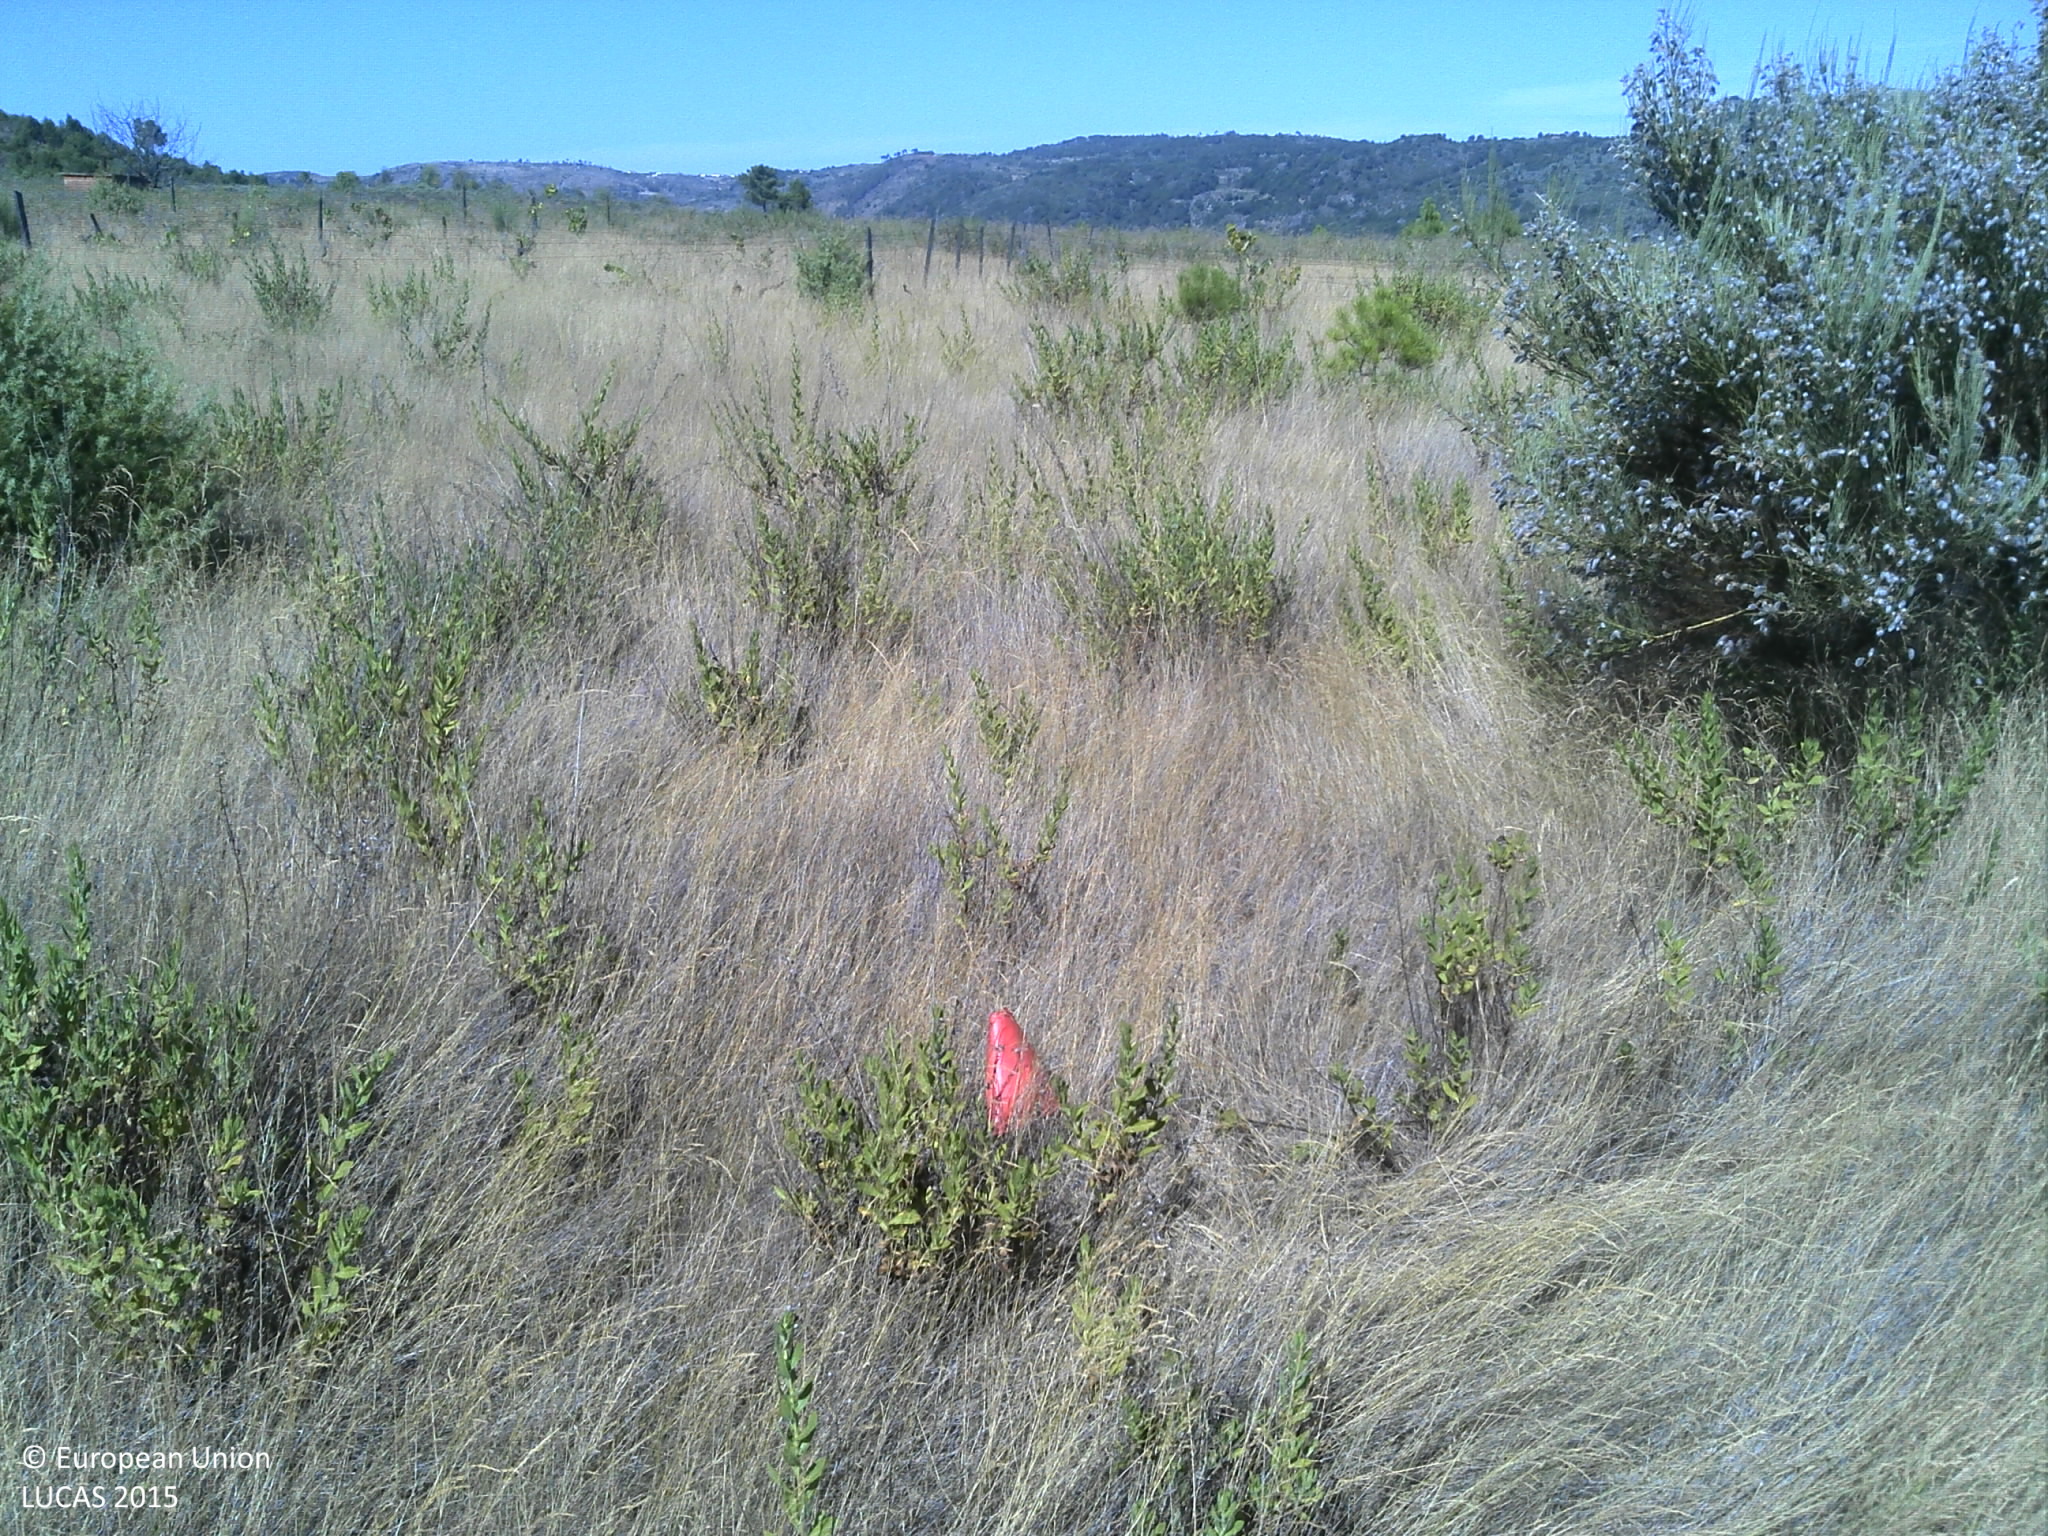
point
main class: Grassland
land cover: Grassland with sparse tree/shrub cover
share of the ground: > 75 %
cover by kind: herbaceous plants 85 %, coniferous forest trees 5 %, shrubs 5 %, unconsolidated bare surface 5 %
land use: Agriculture (excluding fallow land and kitchen gardens)
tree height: < 5 m
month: July
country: PT
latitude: 41.1758
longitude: -7.2694
